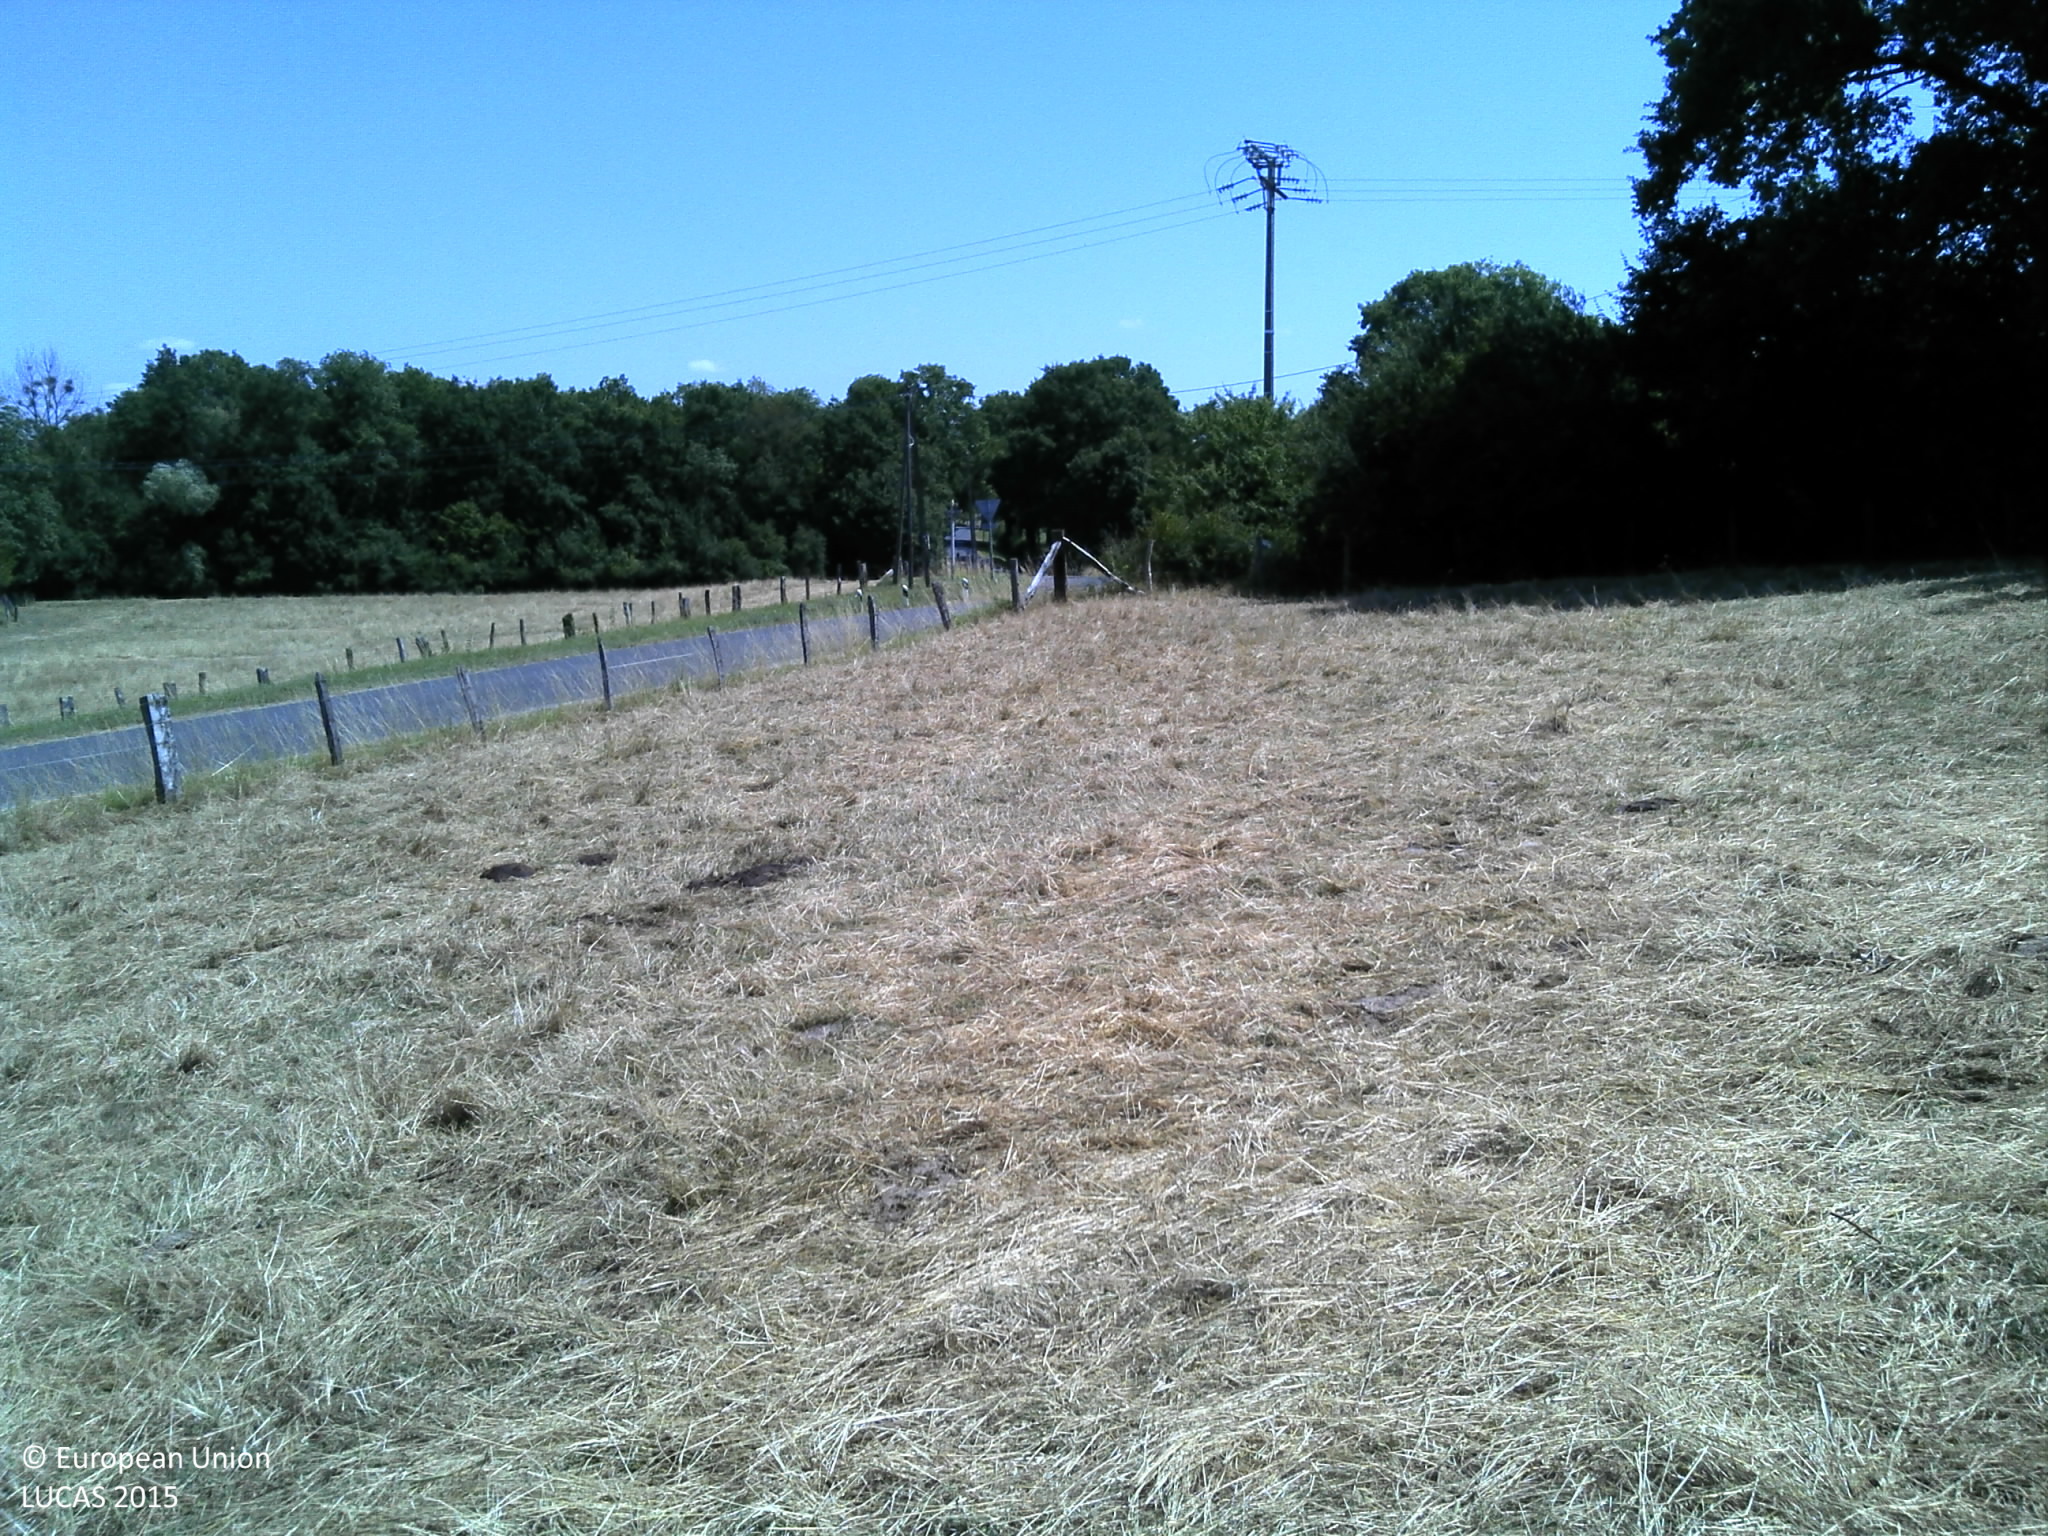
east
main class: Grassland
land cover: Grassland without tree/shrub cover
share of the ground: > 75 %
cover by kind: herbaceous plants 100 %
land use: Agriculture (excluding fallow land and kitchen gardens)
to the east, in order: Grassland without tree/shrub cover; Fences; Abandoned hedges; Tracks; Abandoned hedges; Electric lines; Ditches and canals; Grass margins; Paved roads, cycling and walking lanes; Electric lines; Grassland without tree/shrub cover; Ditches and canals; Lines of trees; Grassland without tree/shrub cover
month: July
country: FR
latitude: 48.6200
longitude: 4.7205
